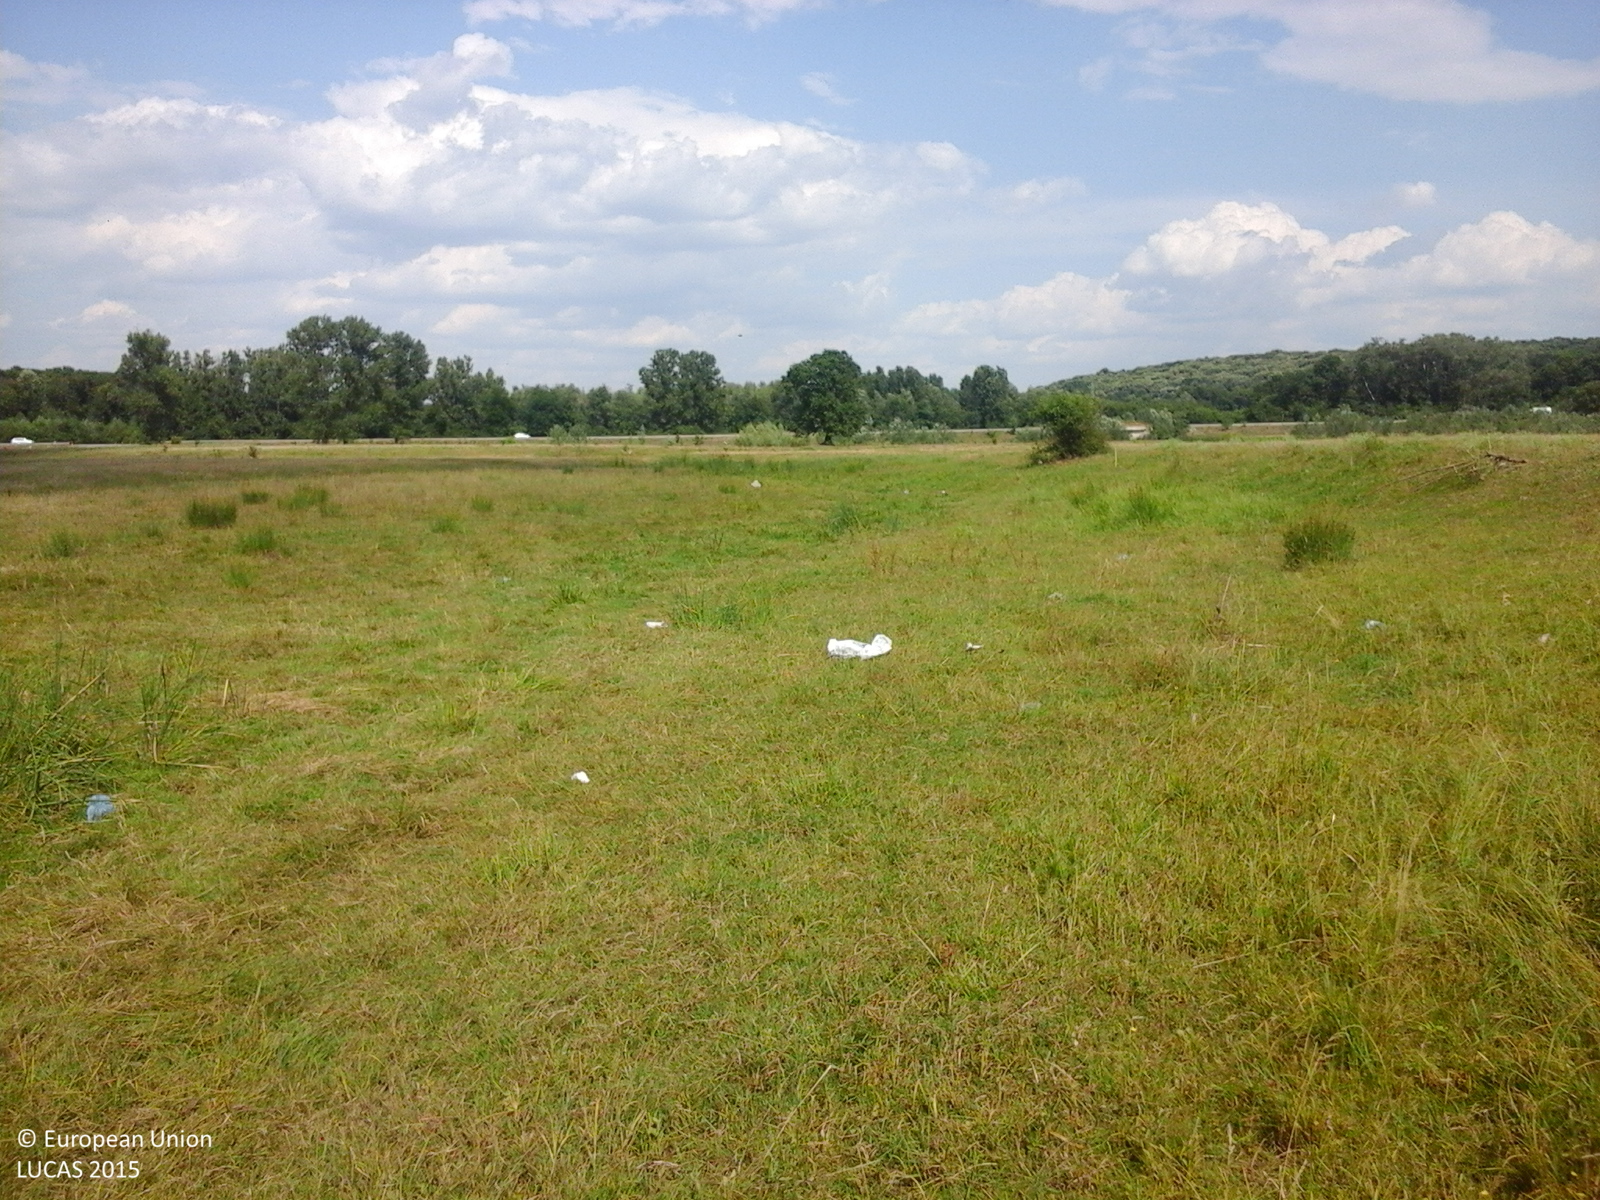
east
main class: Grassland
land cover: Grassland without tree/shrub cover
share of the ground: > 75 %
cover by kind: herbaceous plants 100 %
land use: Agriculture (excluding fallow land and kitchen gardens)
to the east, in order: Grassland without tree/shrub cover; Grassland with sparse tree/shrub cover
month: June
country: RO
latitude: 44.1650
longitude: 25.9944
